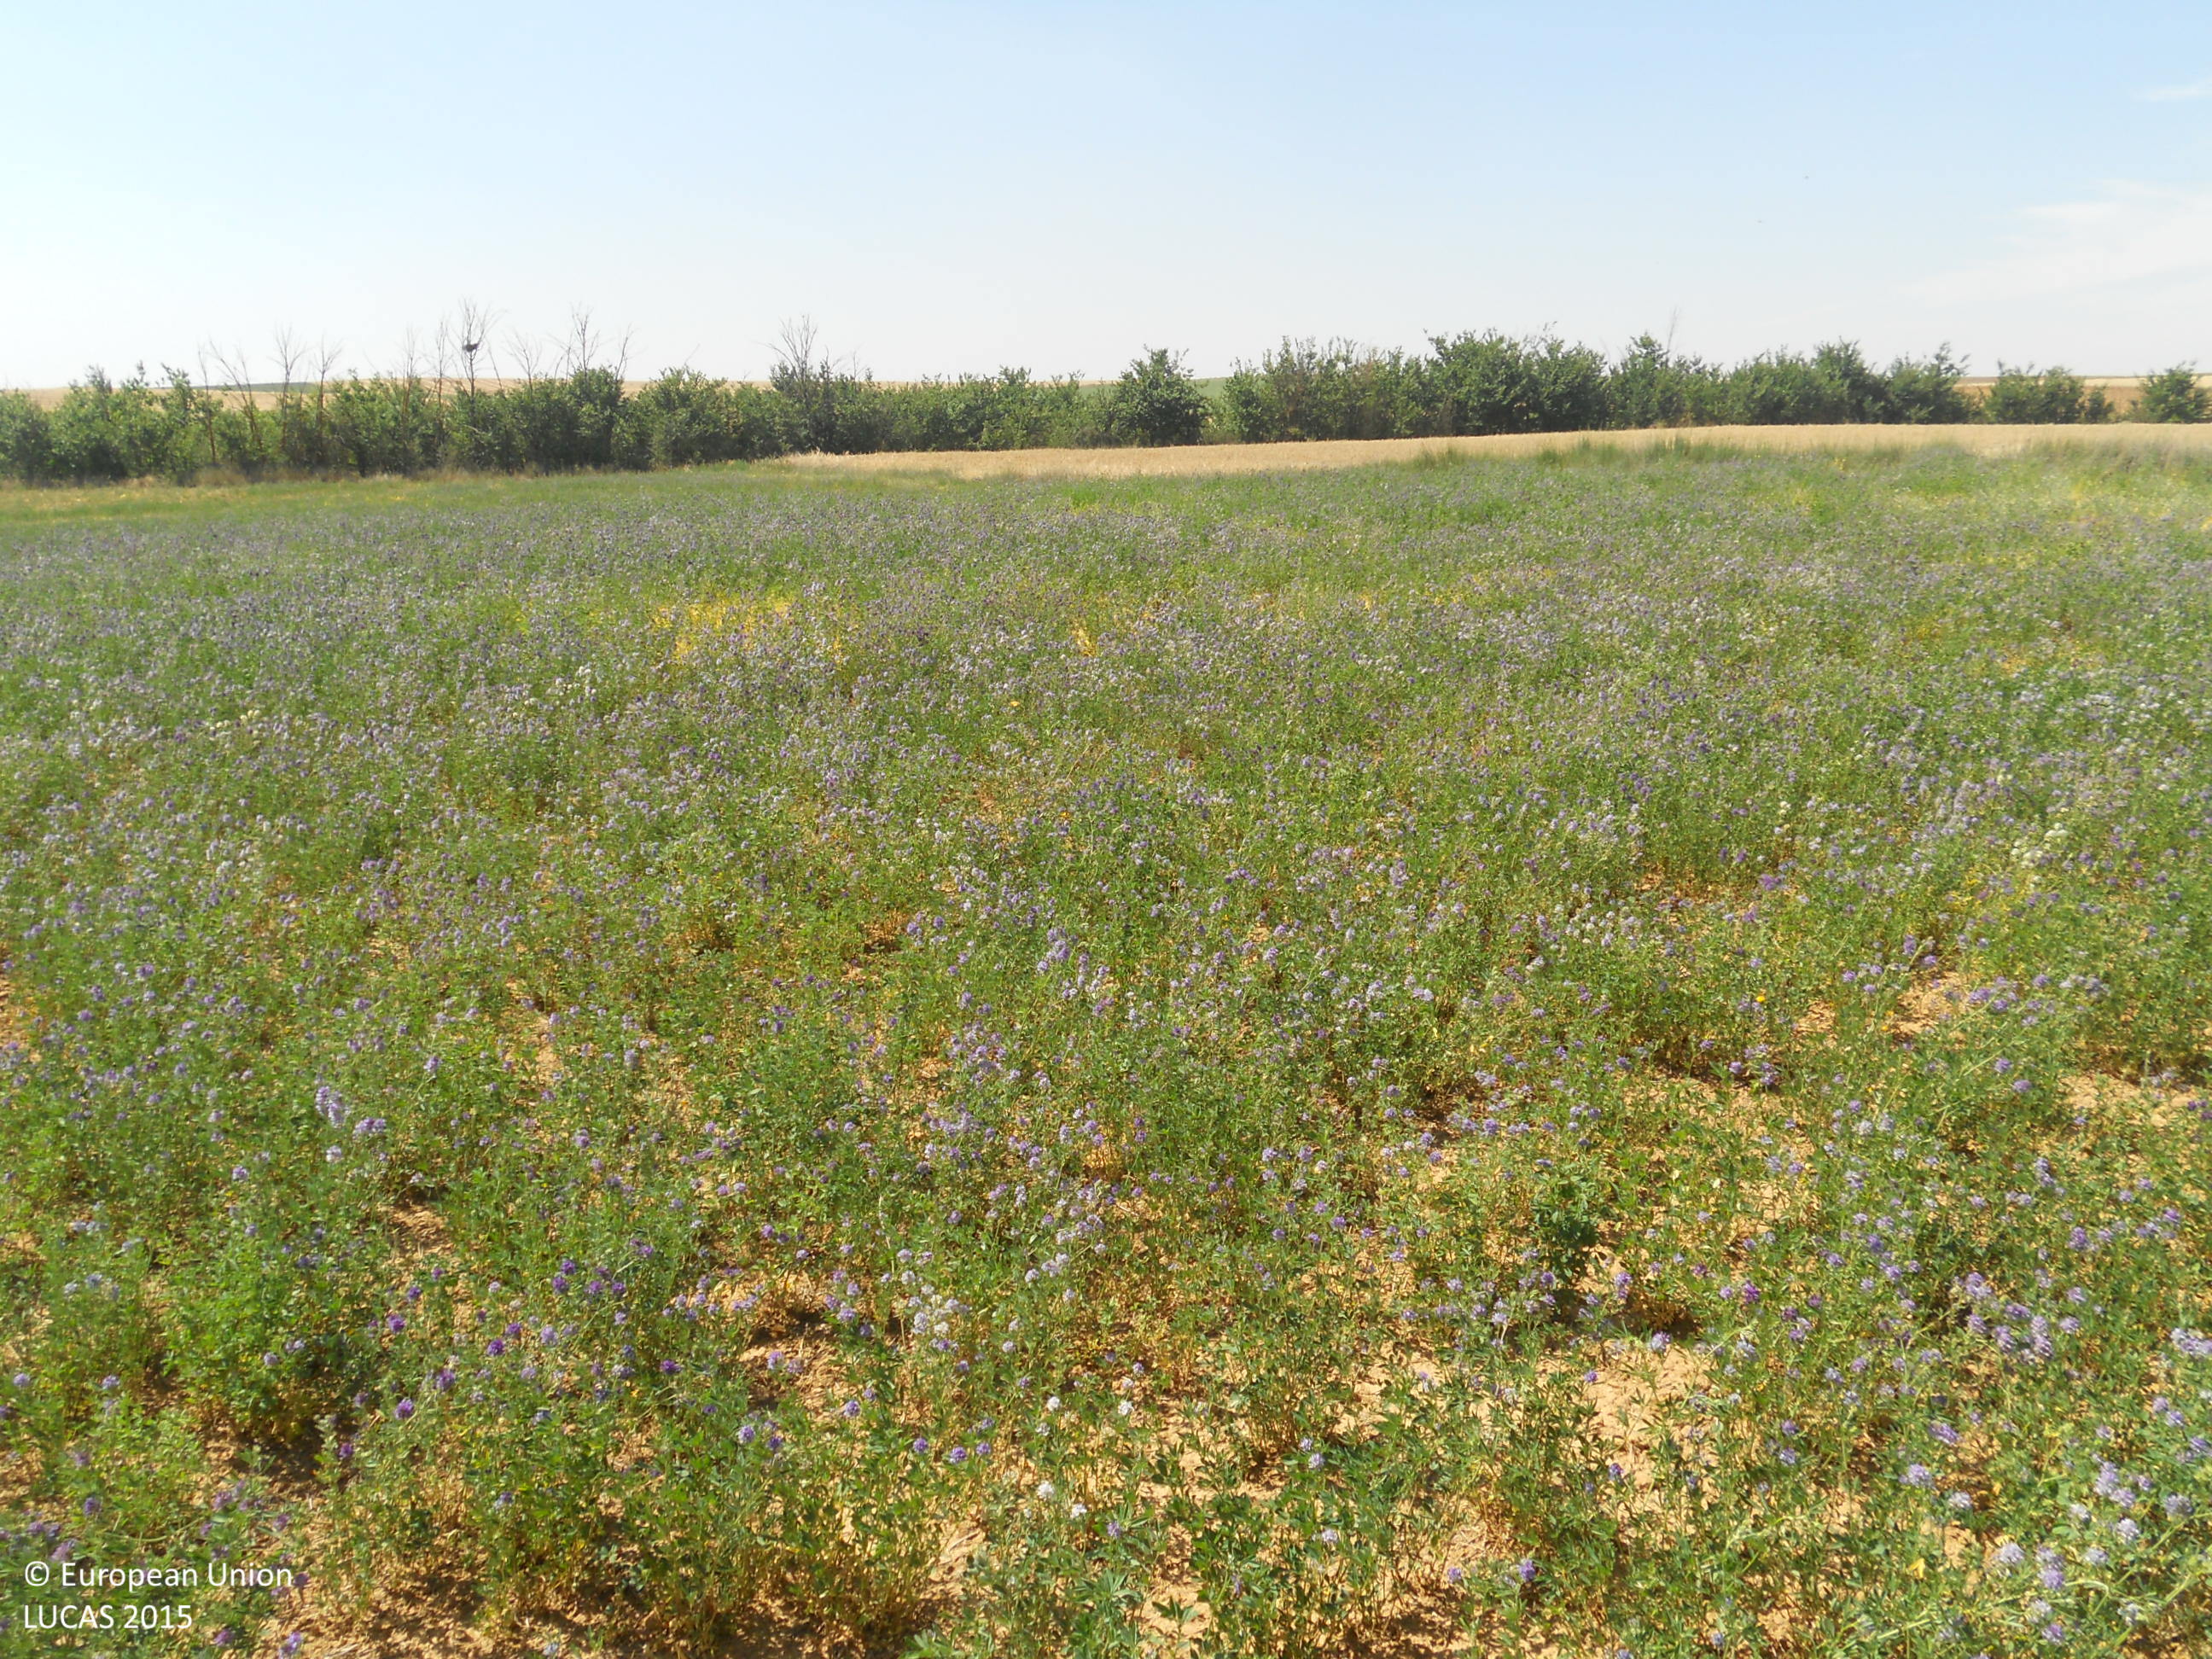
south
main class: Cropland
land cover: Lucerne
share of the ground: > 75 %
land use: Agriculture (excluding fallow land and kitchen gardens)
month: July
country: ES
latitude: 42.2025
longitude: -4.9157
